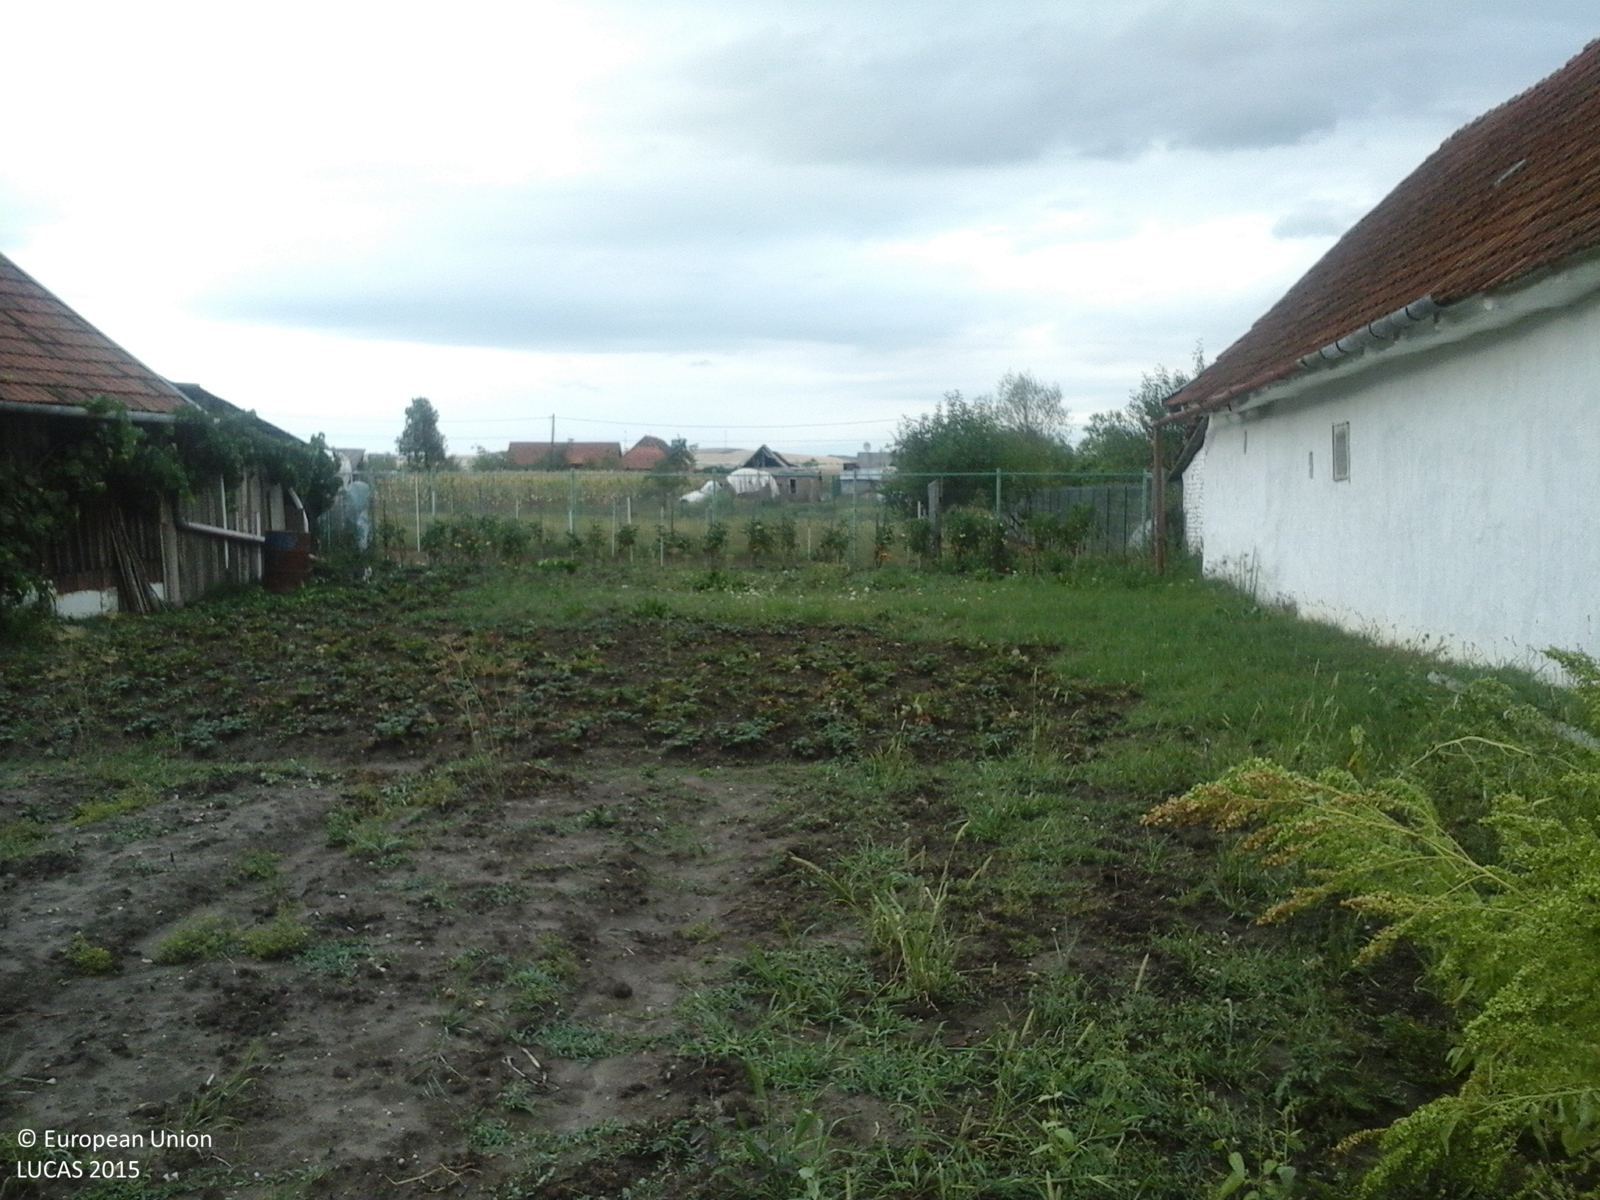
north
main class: Cropland
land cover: Other fruit trees and berries
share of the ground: > 75 %
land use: Agriculture (excluding fallow land and kitchen gardens)
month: August
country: RO
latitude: 45.7821
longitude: 21.6762
